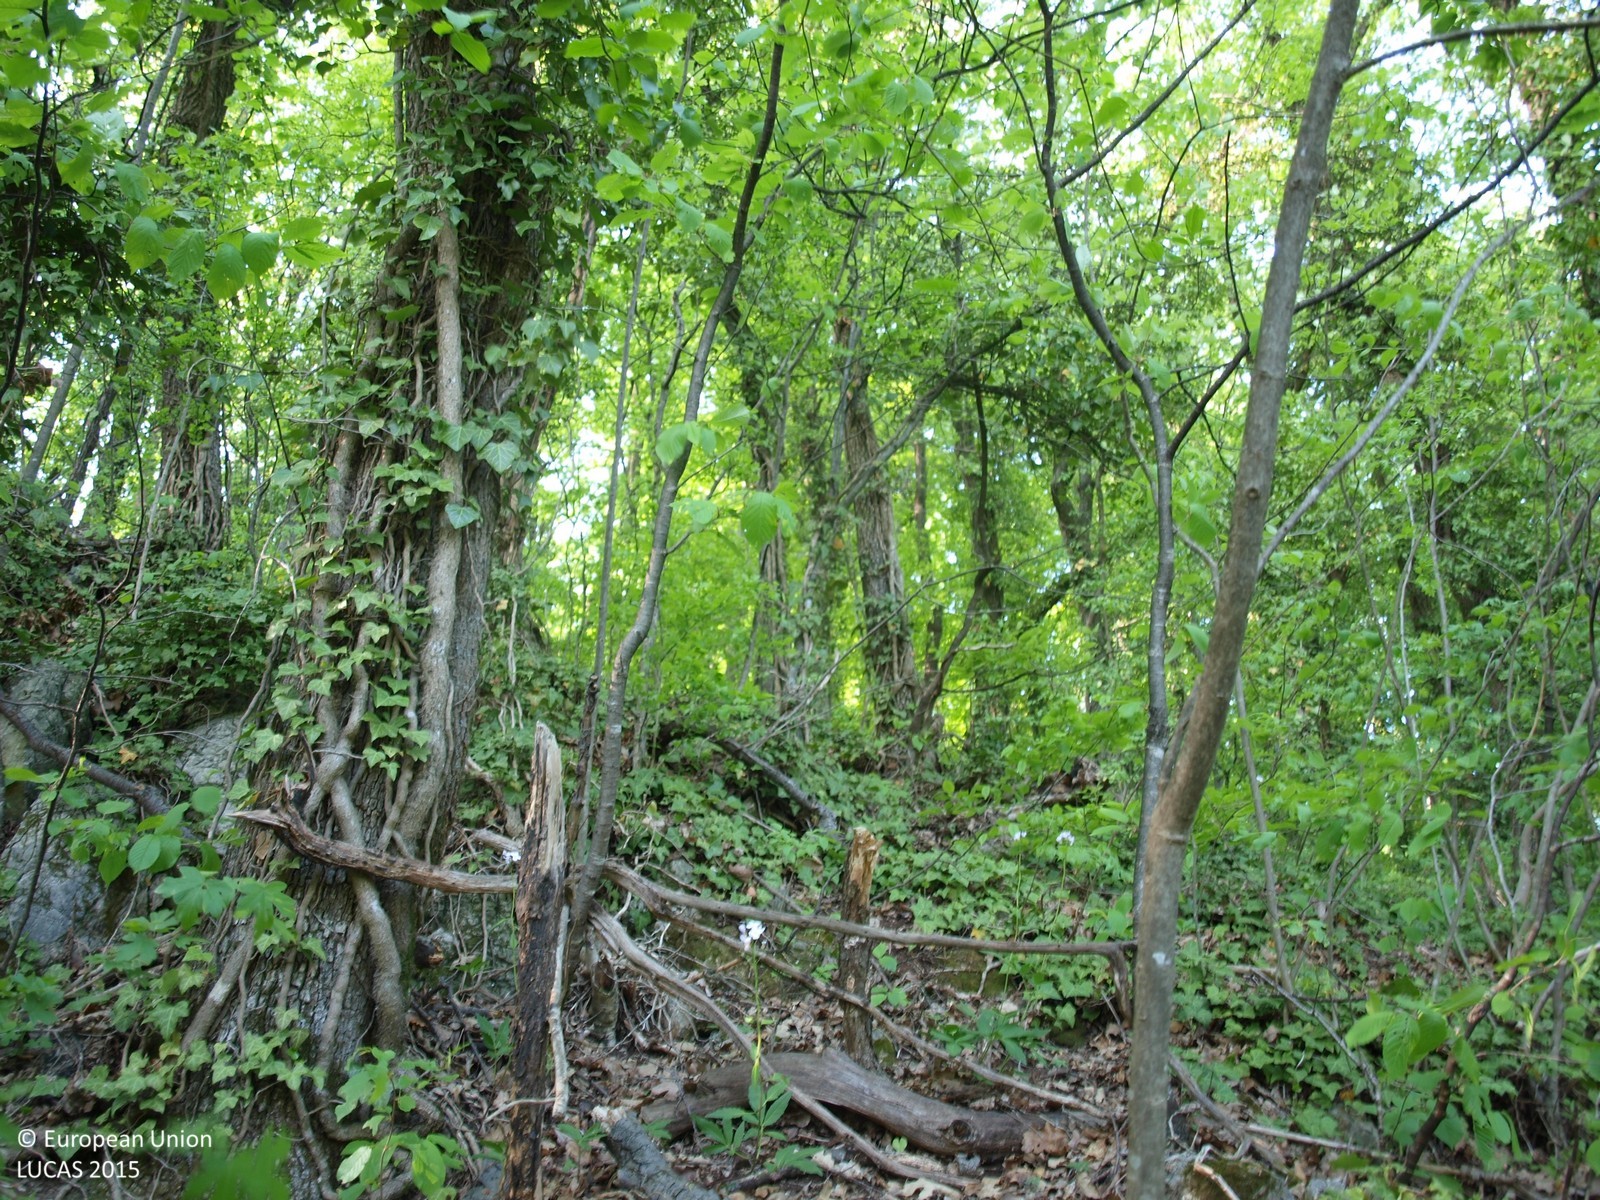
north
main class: Woodland
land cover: Broadleaved woodland
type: mesophytic deciduous forest
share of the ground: > 75 %
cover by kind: broadleaved forest trees 90 %, shrubs 5 %, herbaceous plants 5 %
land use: Forestry
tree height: > 5 m
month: April
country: HR
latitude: 46.2009
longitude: 15.9992
